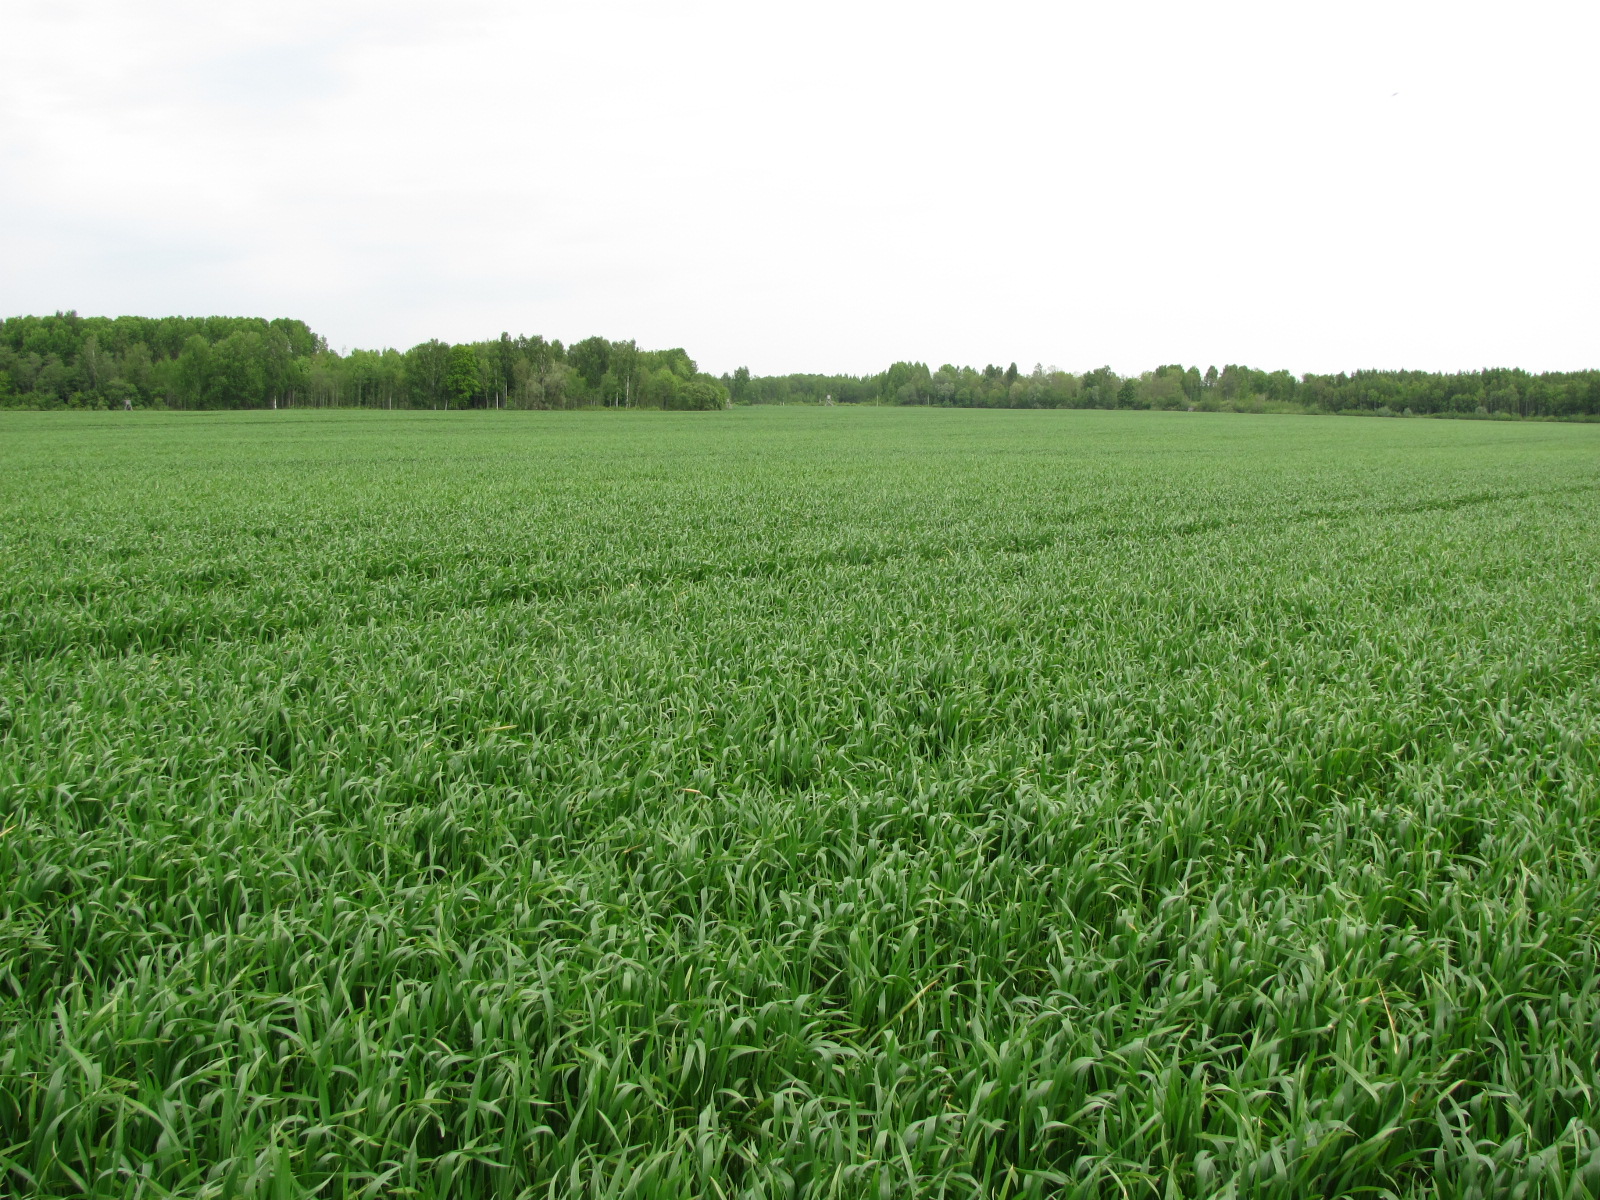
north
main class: Cropland
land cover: Common wheat
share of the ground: > 75 %
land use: Agriculture (excluding fallow land and kitchen gardens)
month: May
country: LV
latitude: 56.4440
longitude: 24.1194
